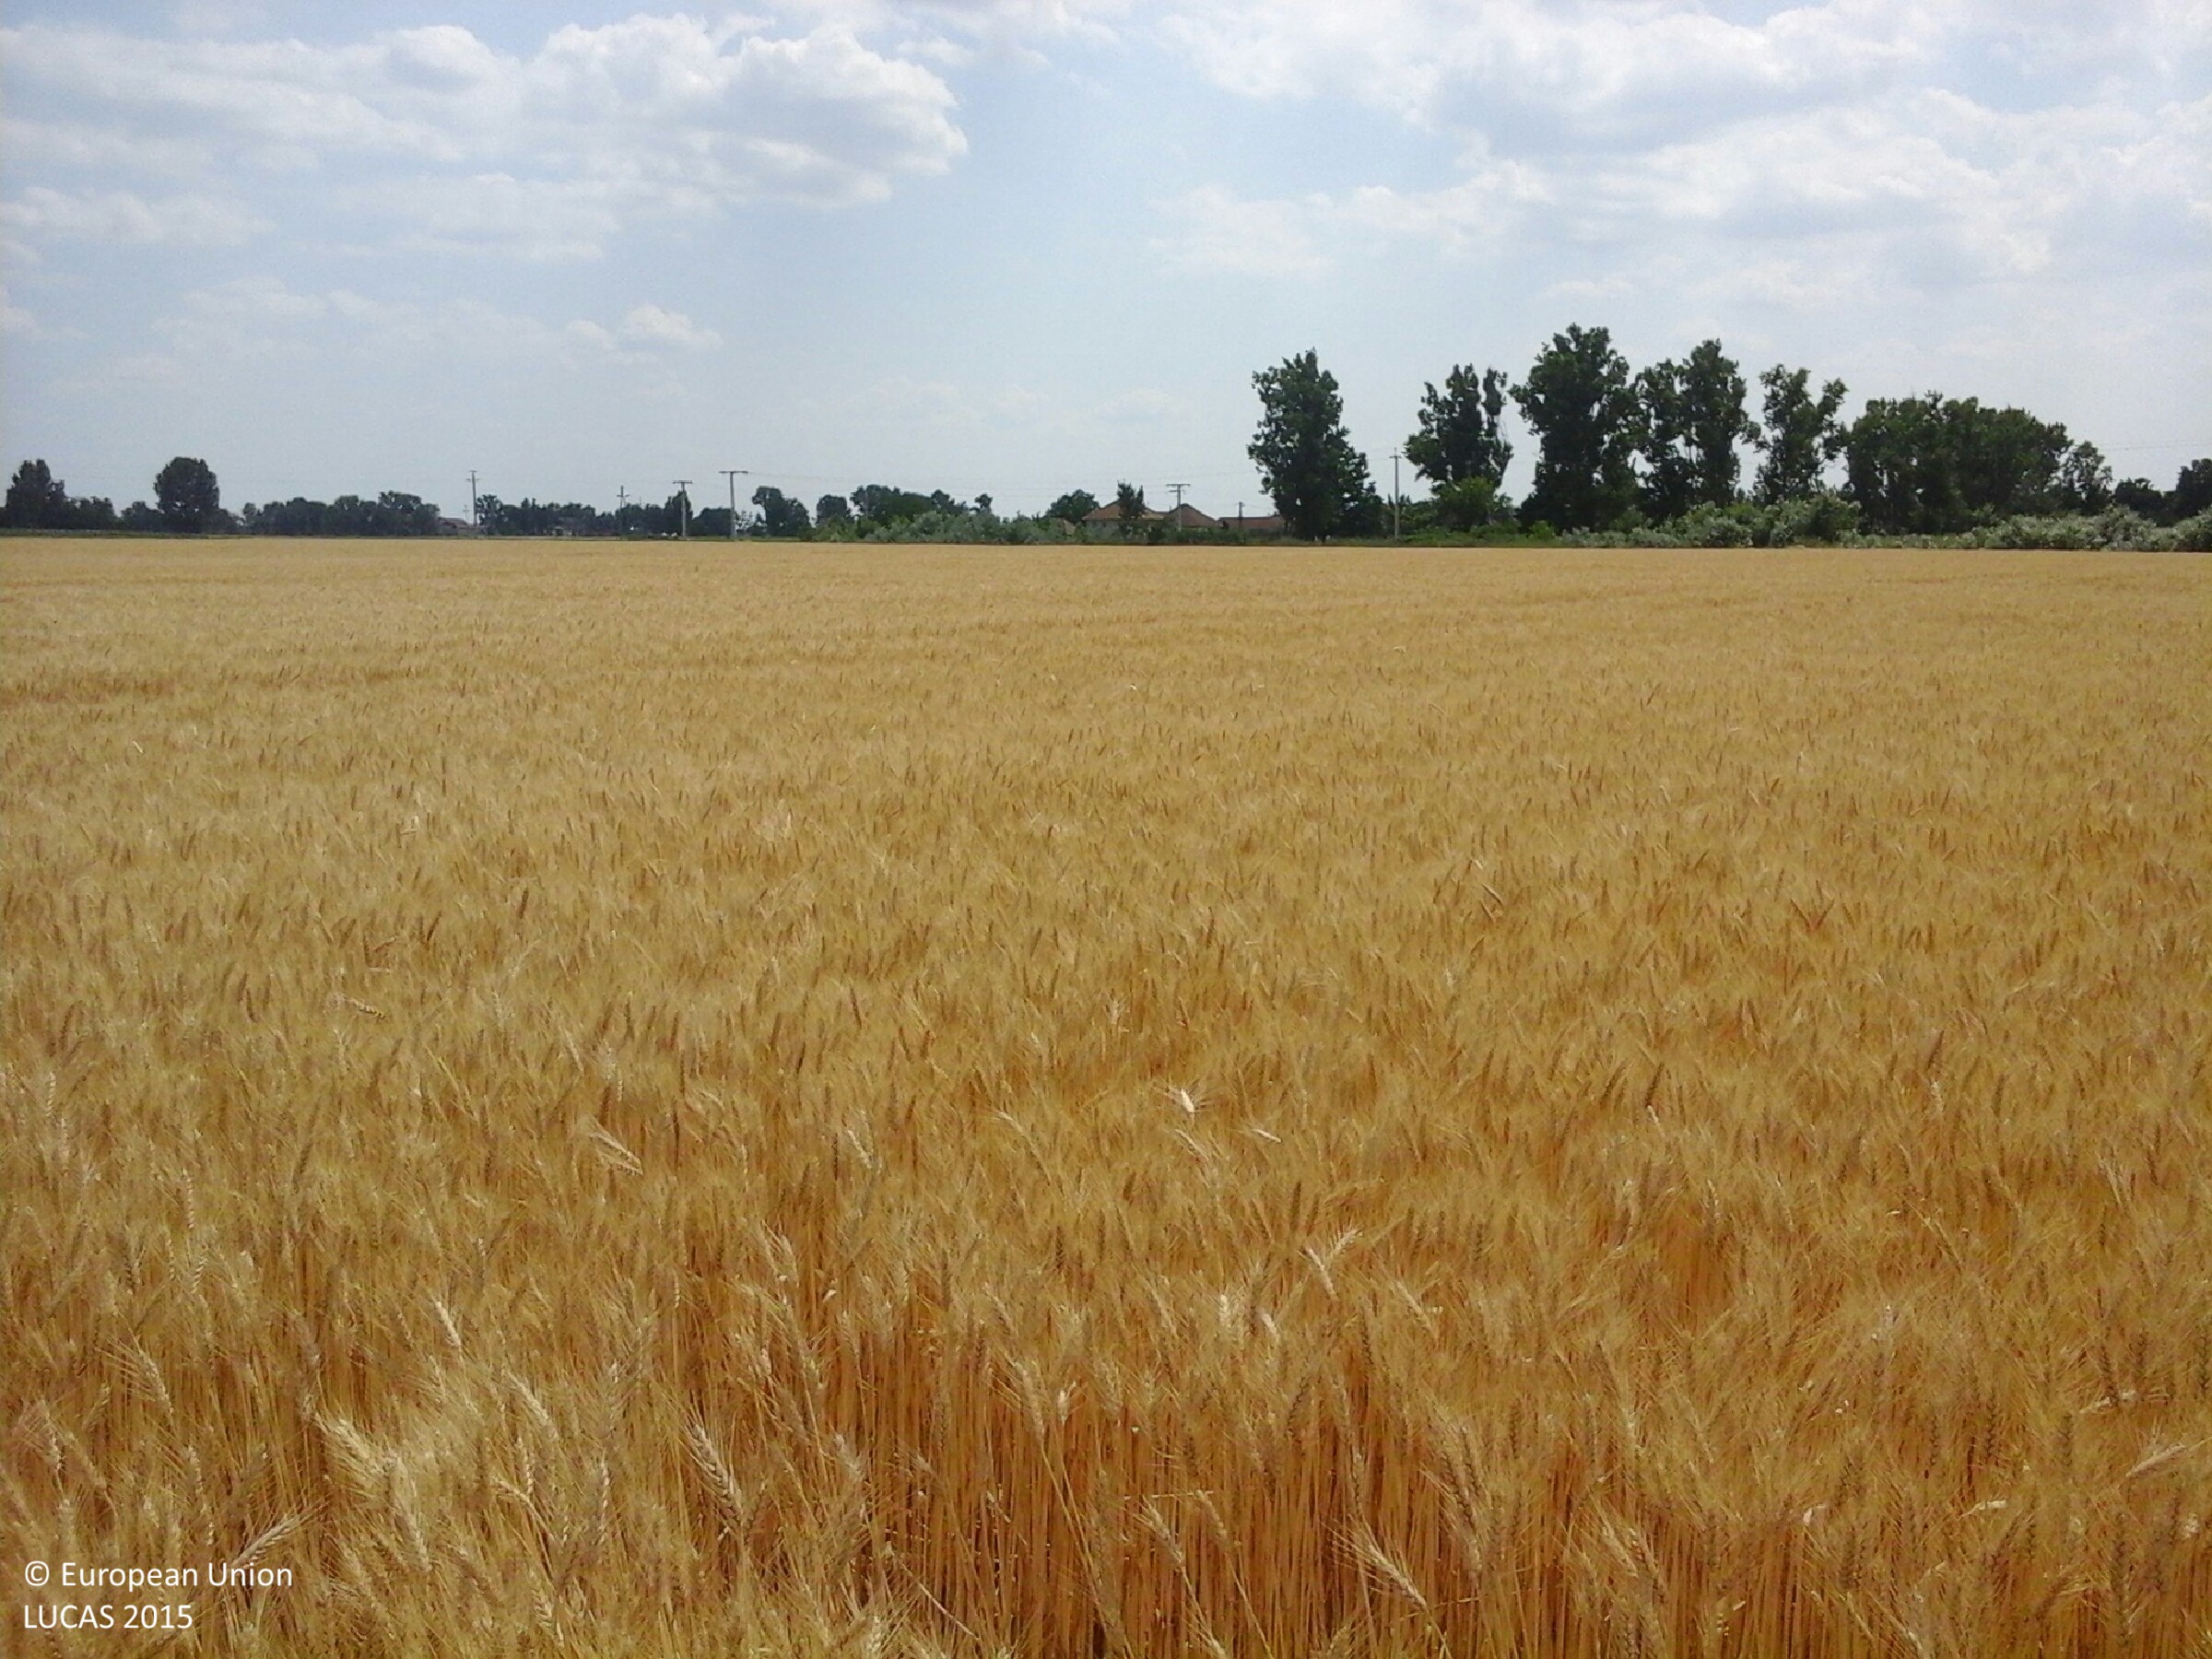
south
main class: Cropland
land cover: Common wheat
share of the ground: > 75 %
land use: Agriculture (excluding fallow land and kitchen gardens)
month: July
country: HU
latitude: 47.7767
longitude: 20.6703
